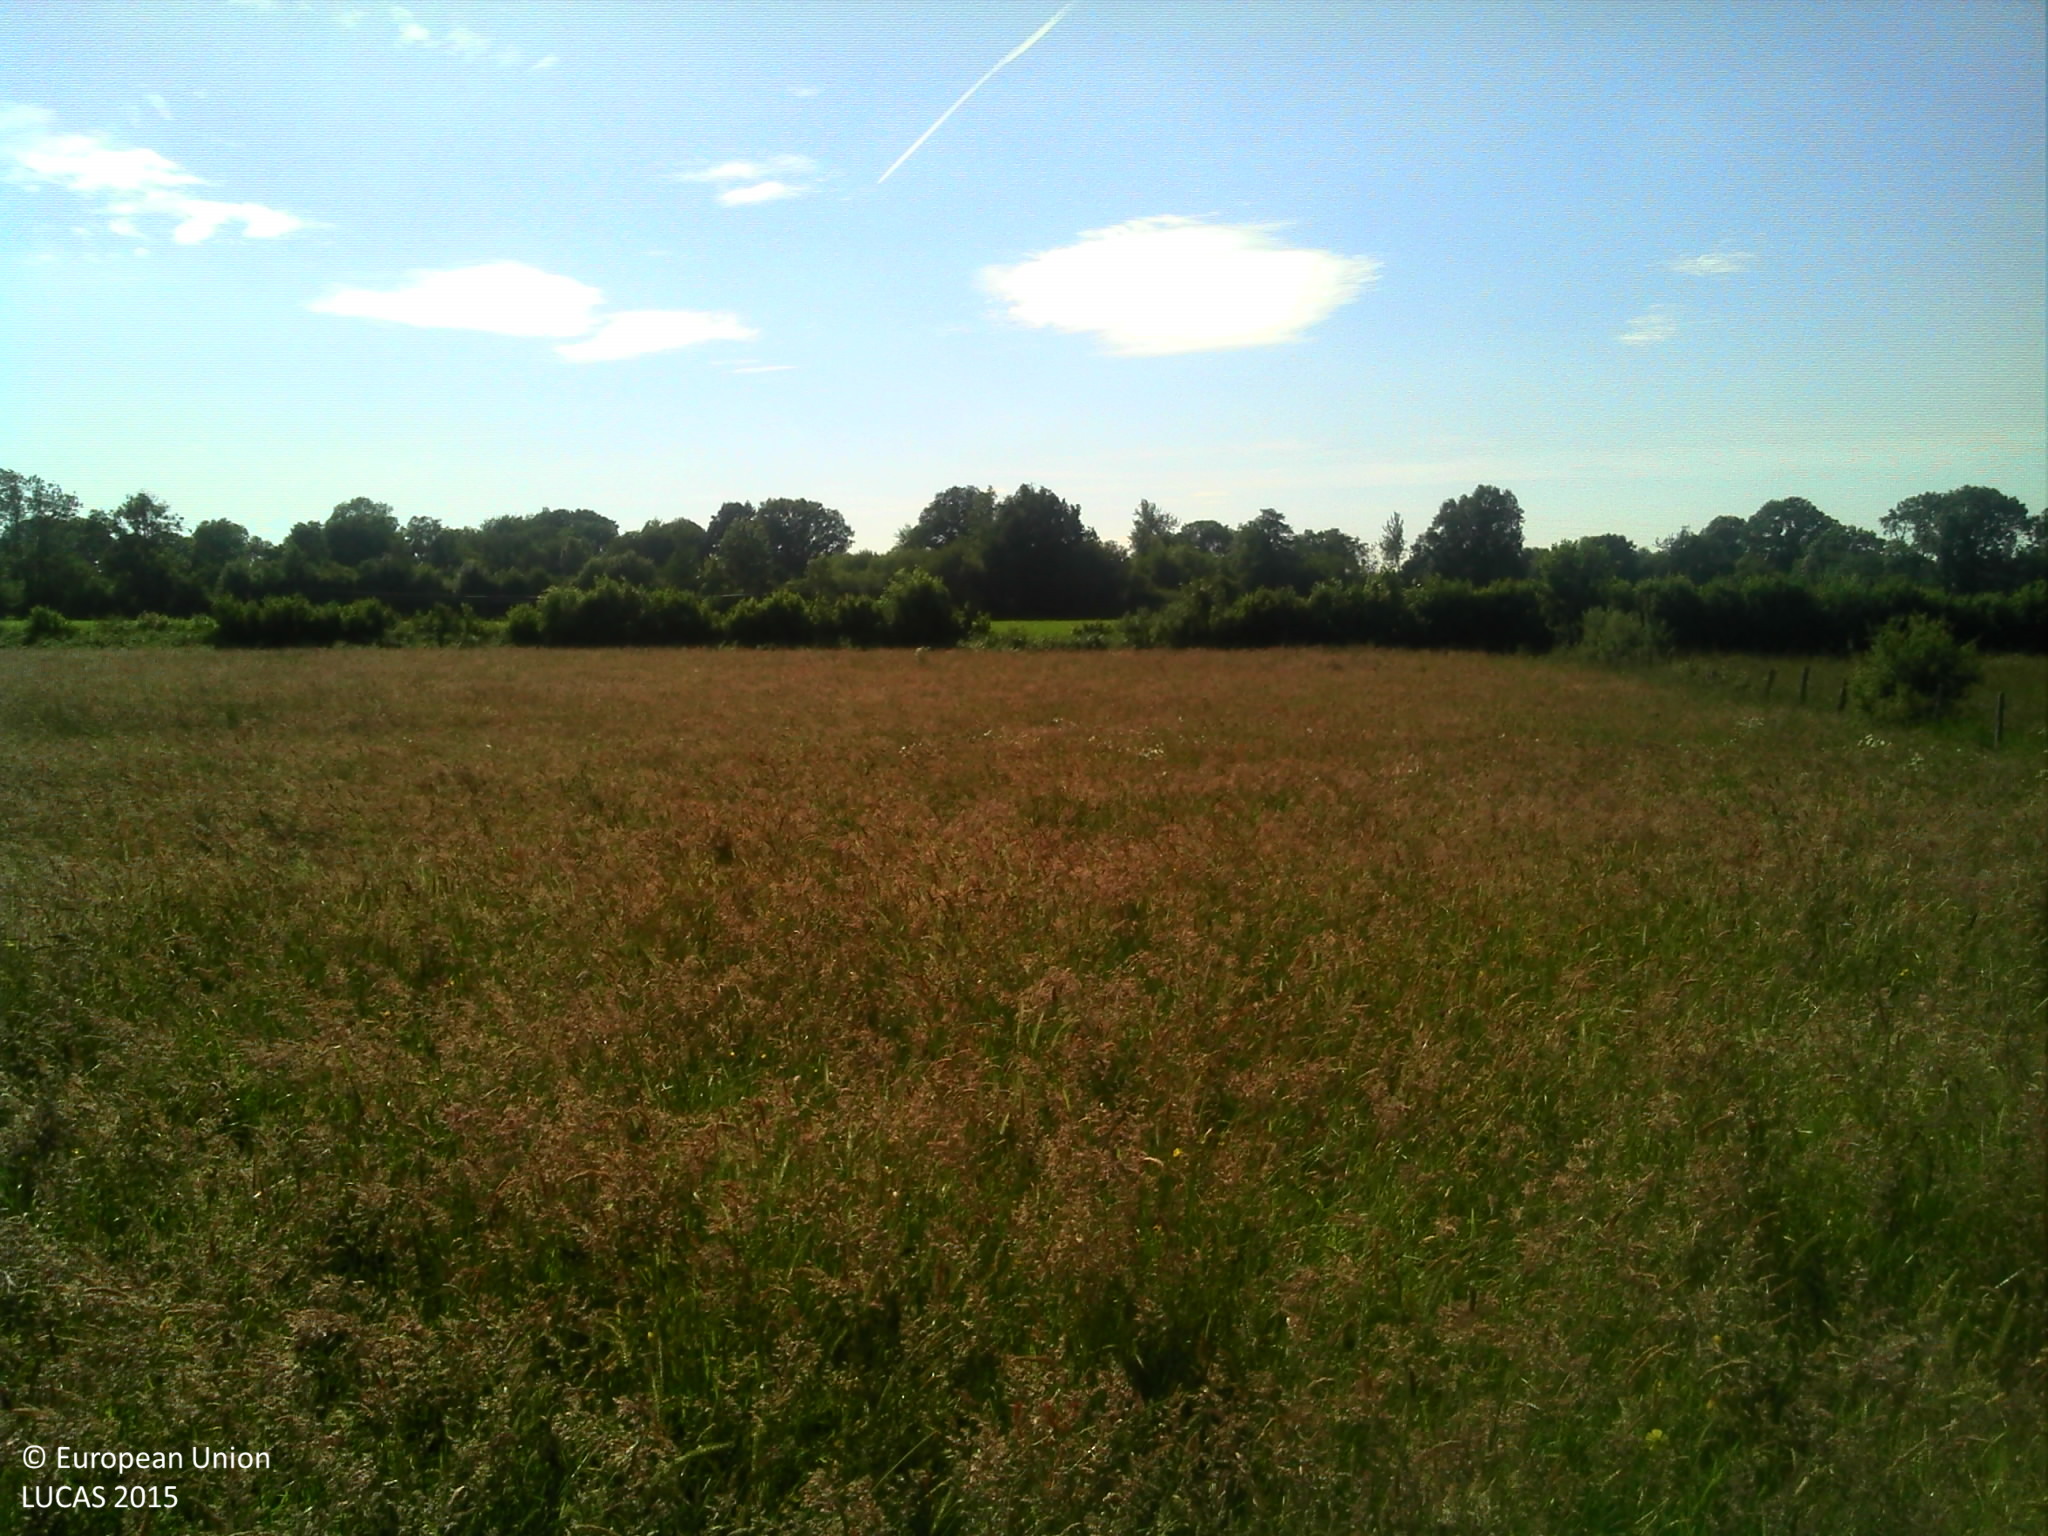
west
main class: Grassland
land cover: Grassland without tree/shrub cover
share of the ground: > 75 %
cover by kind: herbaceous plants 100 %
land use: Agriculture (excluding fallow land and kitchen gardens)
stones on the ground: < 10 %
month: June
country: FR
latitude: 48.5921
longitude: -0.1047
